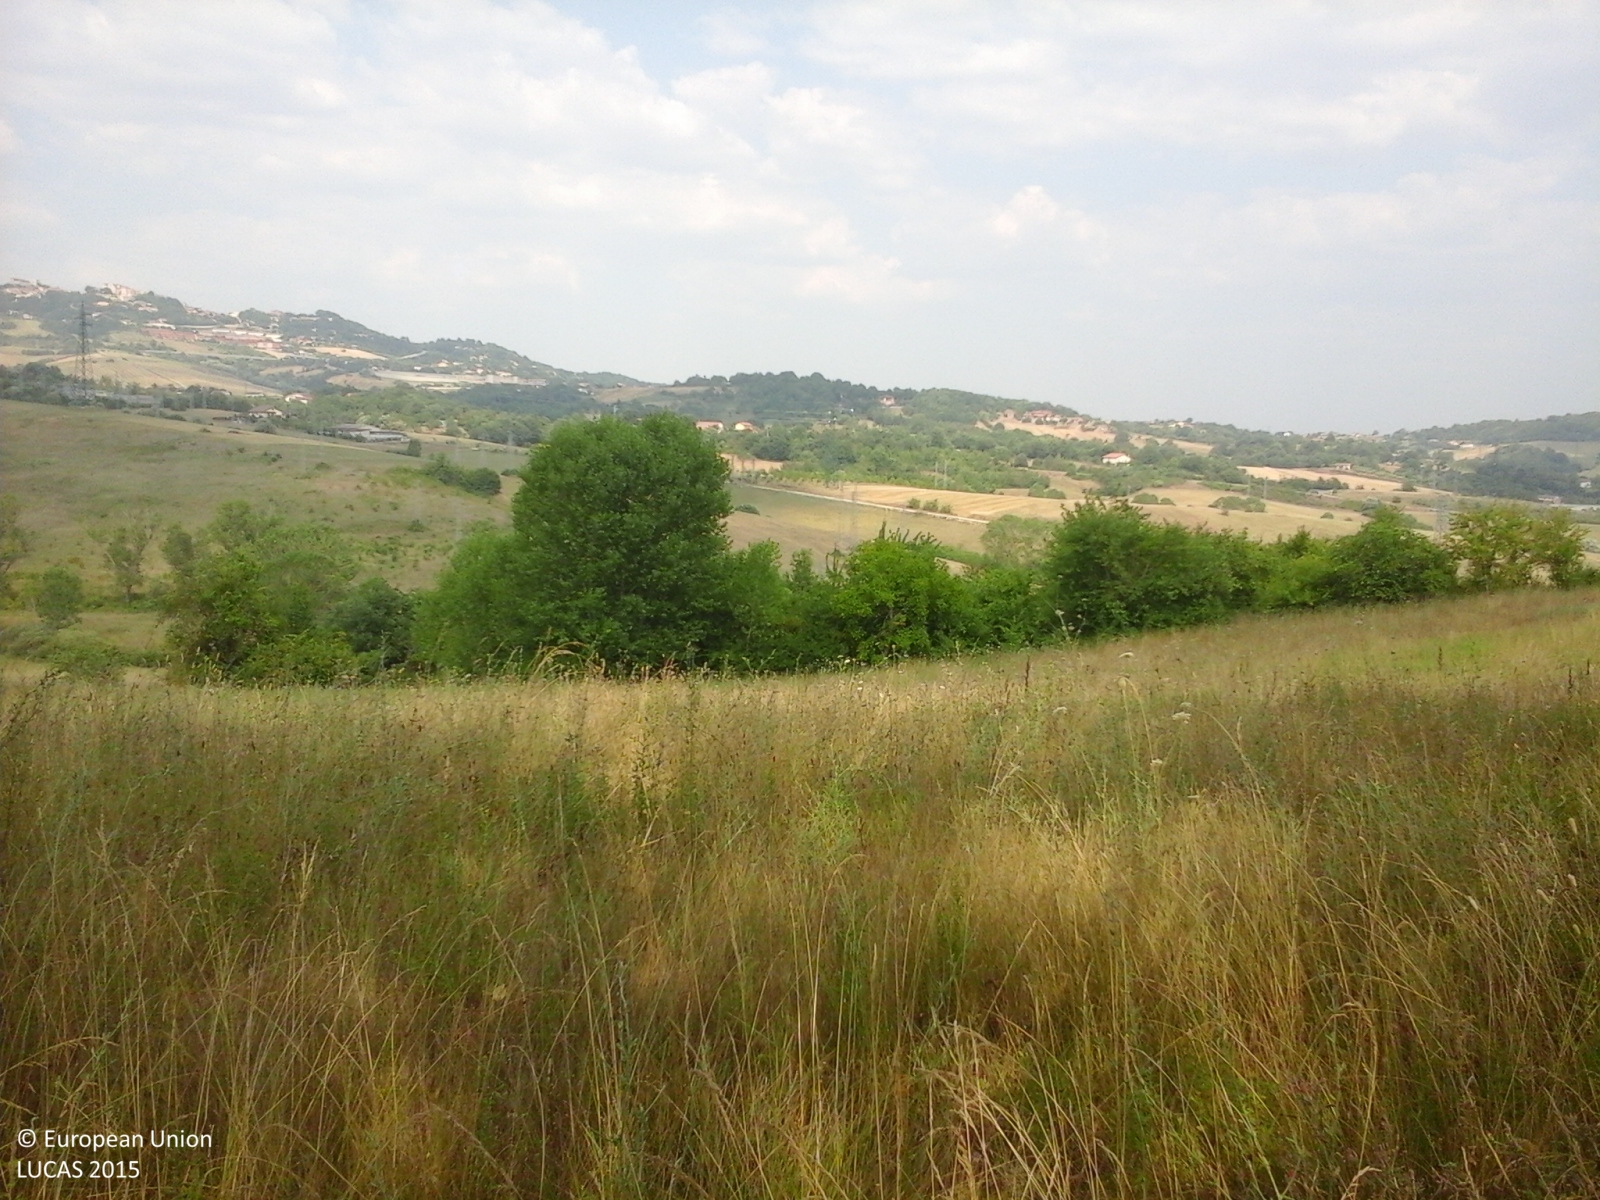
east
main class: Grassland
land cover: Grassland without tree/shrub cover
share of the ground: > 75 %
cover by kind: herbaceous plants 95 %, shrubs 5 %
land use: Abandoned areas
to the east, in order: Grassland without tree/shrub cover; Shrubland with sparse tree cover; Grassland without tree/shrub cover; Broadleaved woodland; Shrubland without tree cover; Electric lines; Shrubland without tree cover
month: July
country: IT
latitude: 40.9118
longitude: 15.1448
